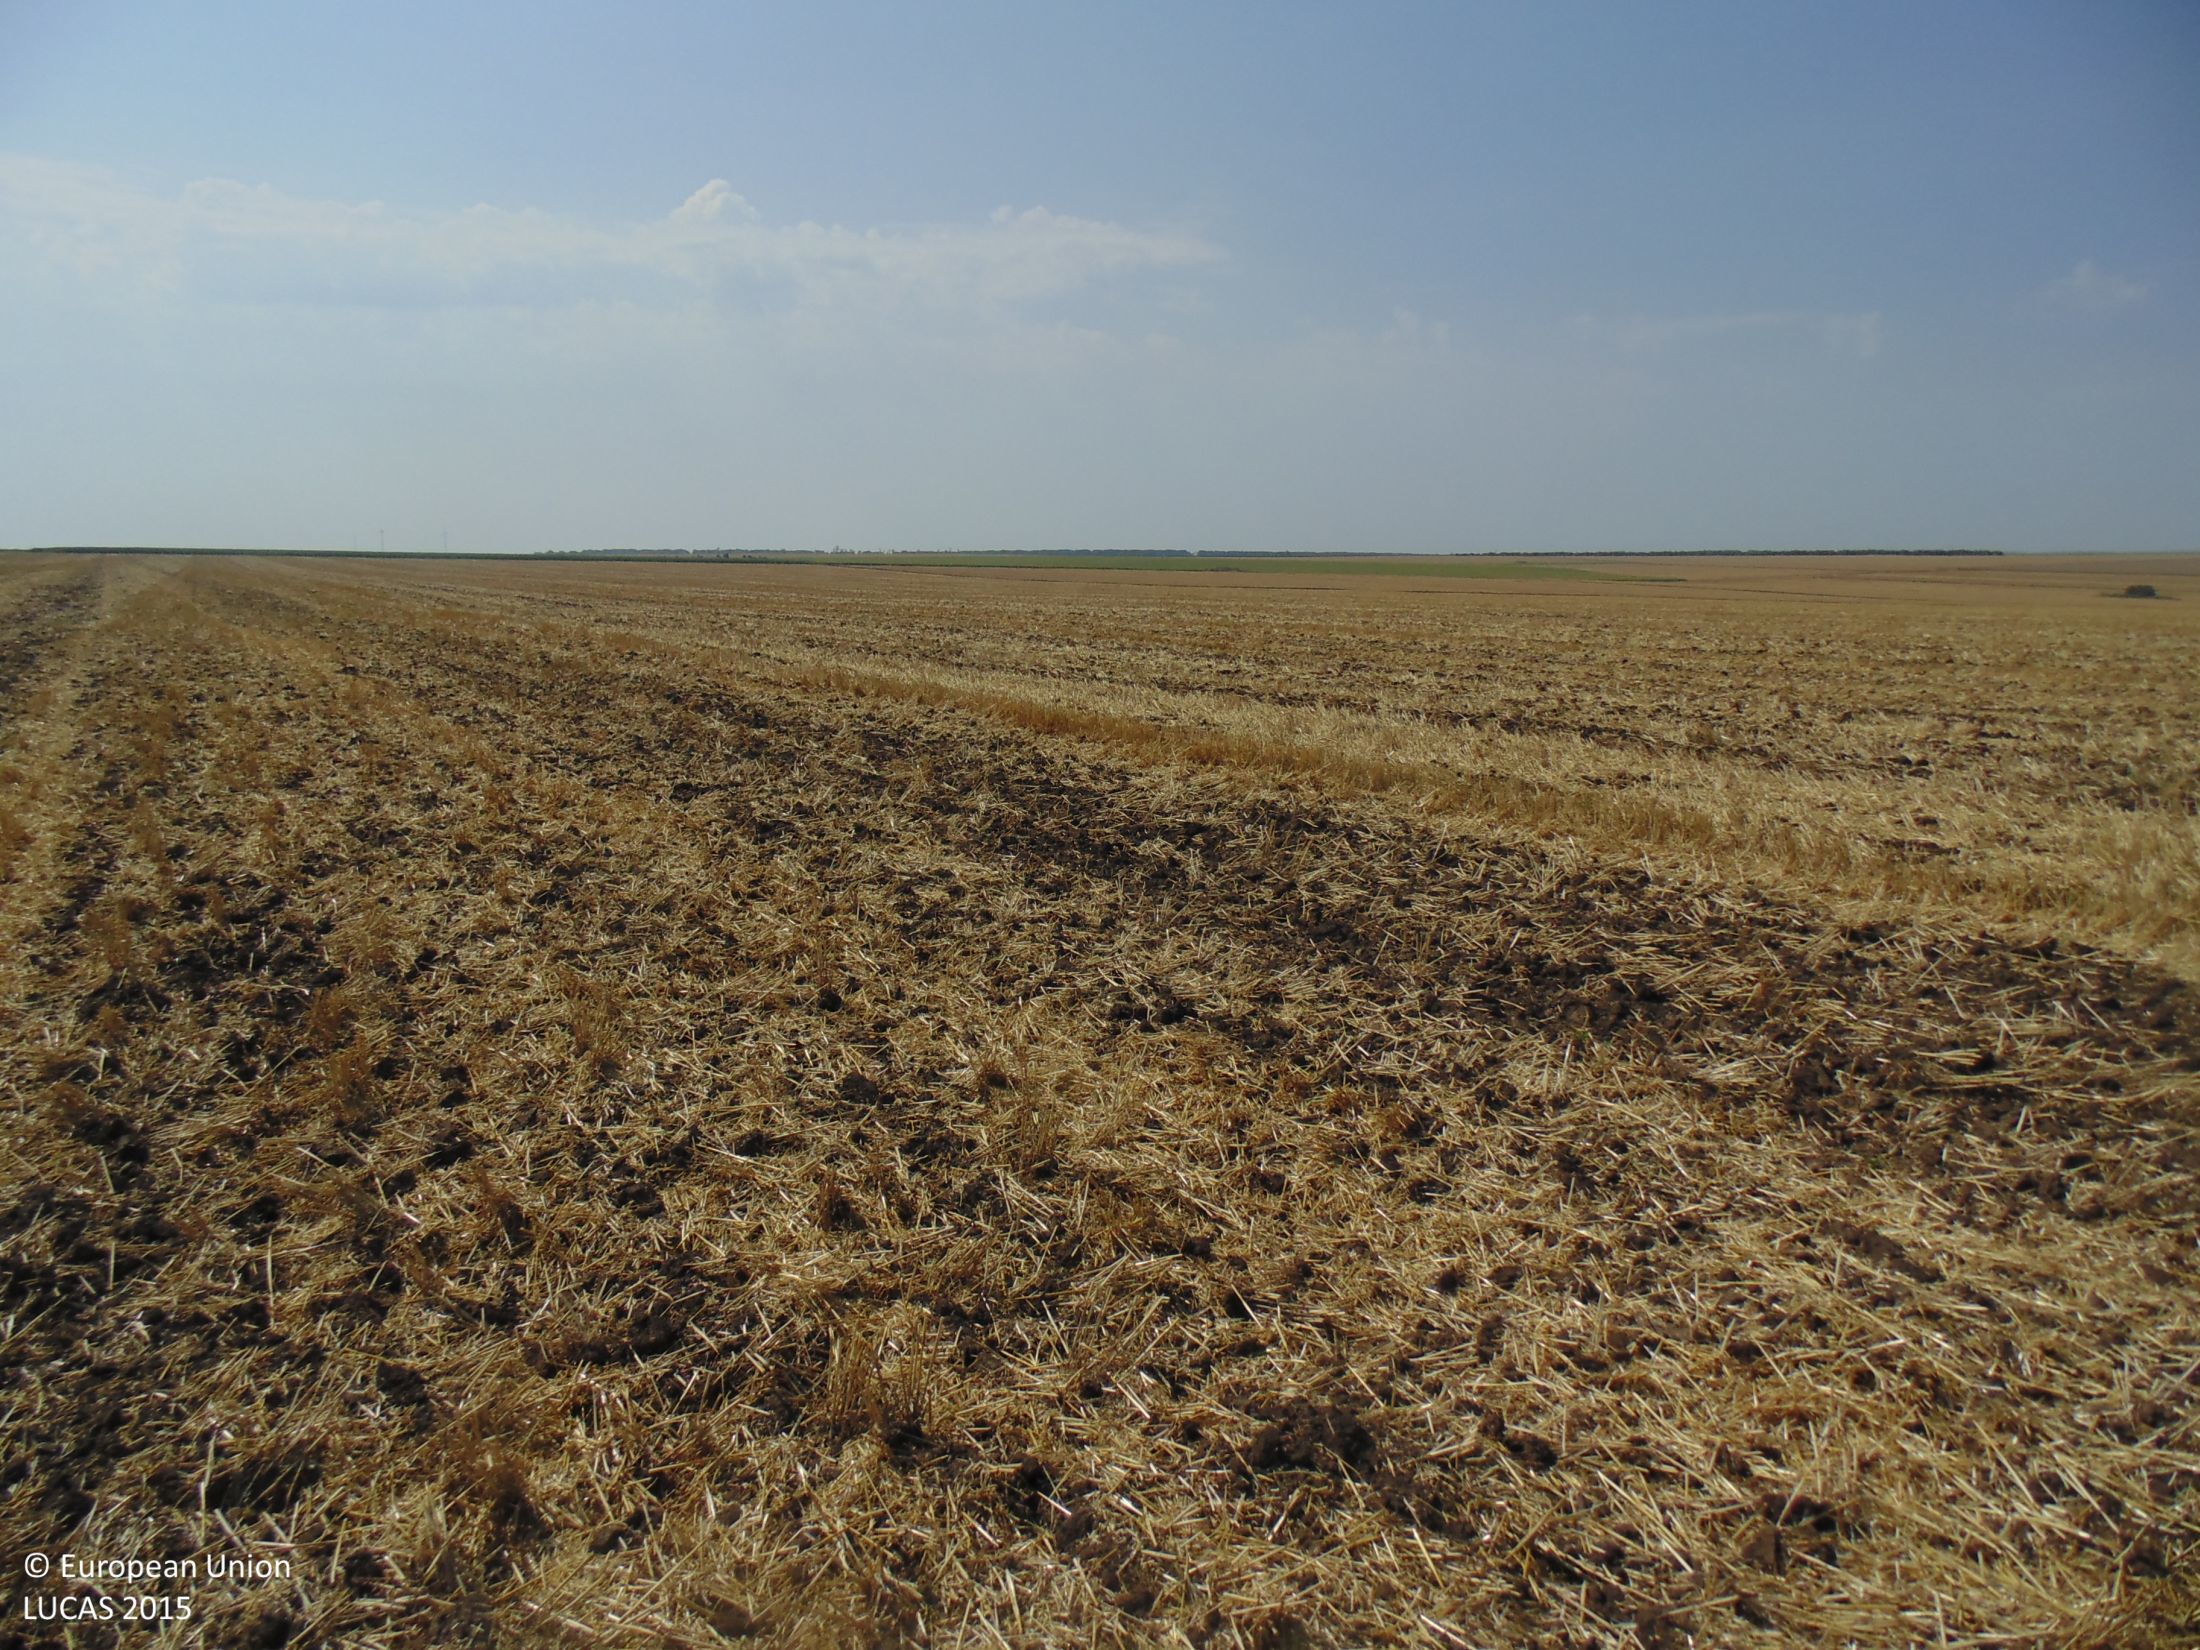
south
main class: Cropland
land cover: Common wheat
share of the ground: 10 - 25 %
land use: Agriculture (excluding fallow land and kitchen gardens)
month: July
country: BG
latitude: 43.5084
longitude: 27.9433
